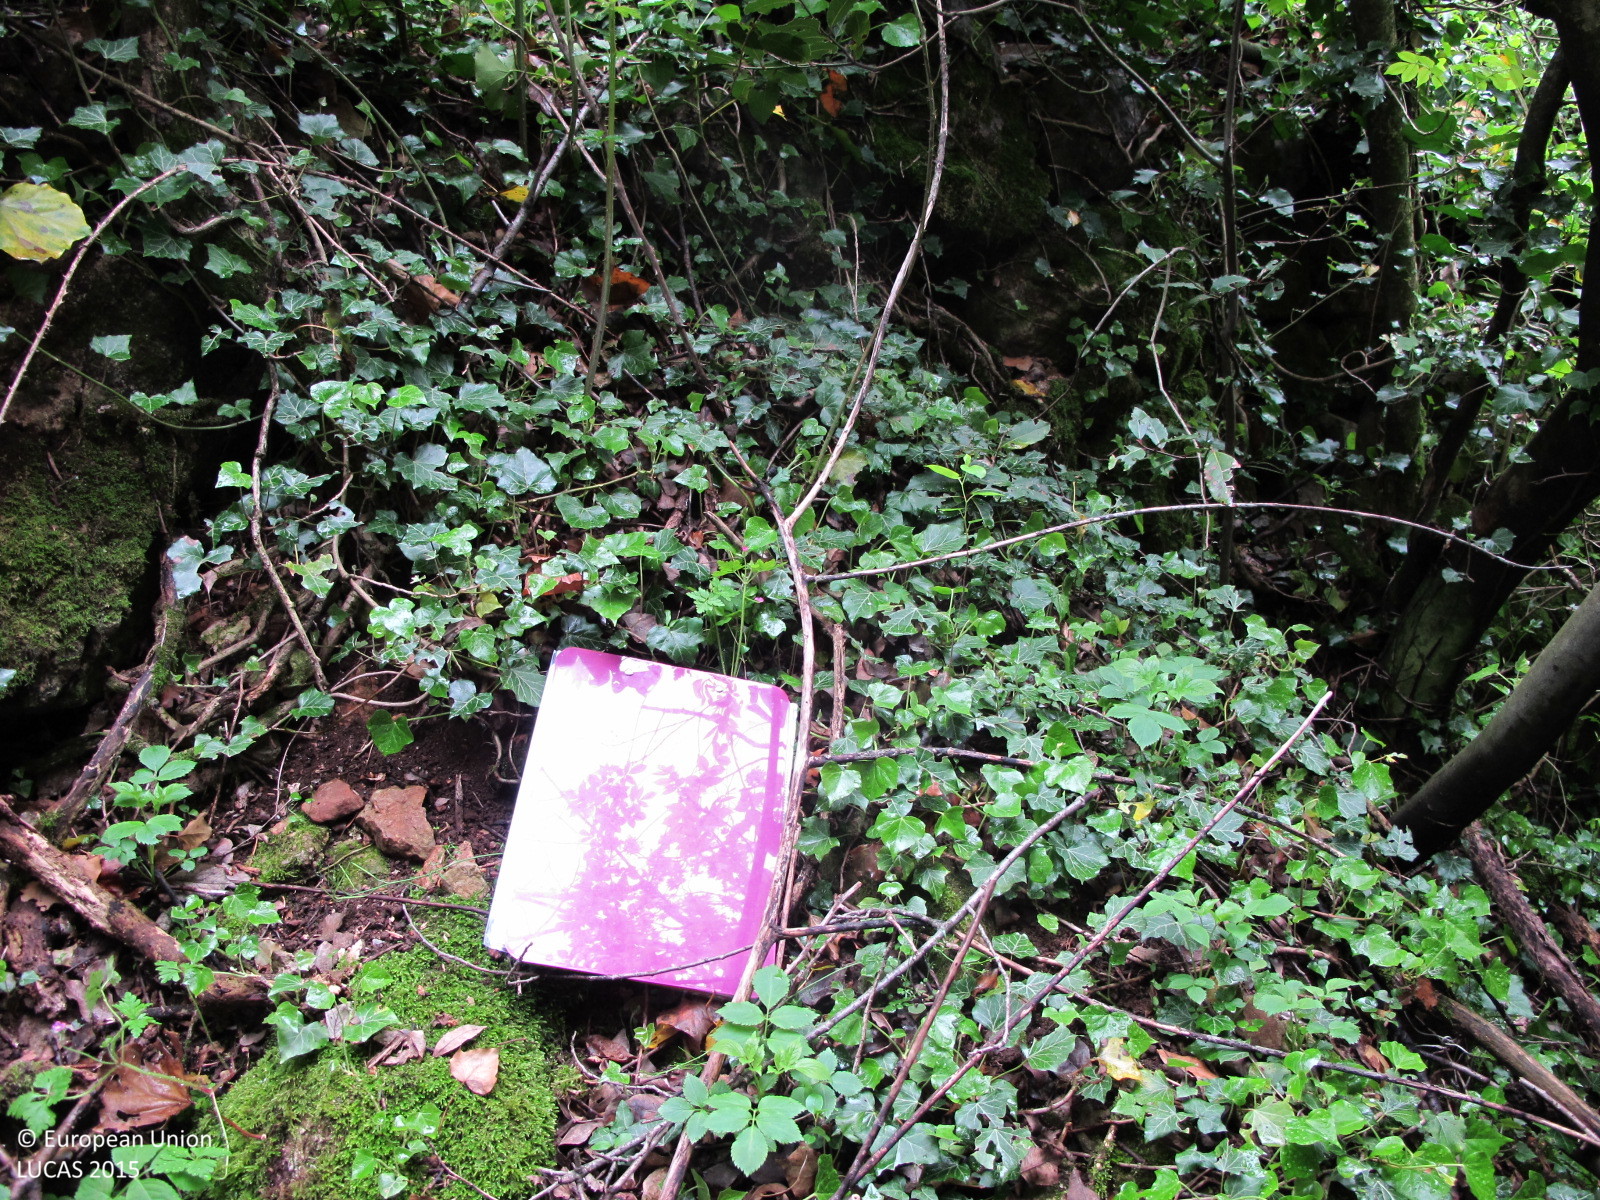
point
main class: Woodland
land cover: Broadleaved woodland
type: broadleaved evergreen forest
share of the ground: > 75 %
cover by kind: broadleaved forest trees 80 %, shrubs 15 %
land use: Semi-natural and natural areas not in use
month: April
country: HR
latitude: 45.3448
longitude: 14.2960
